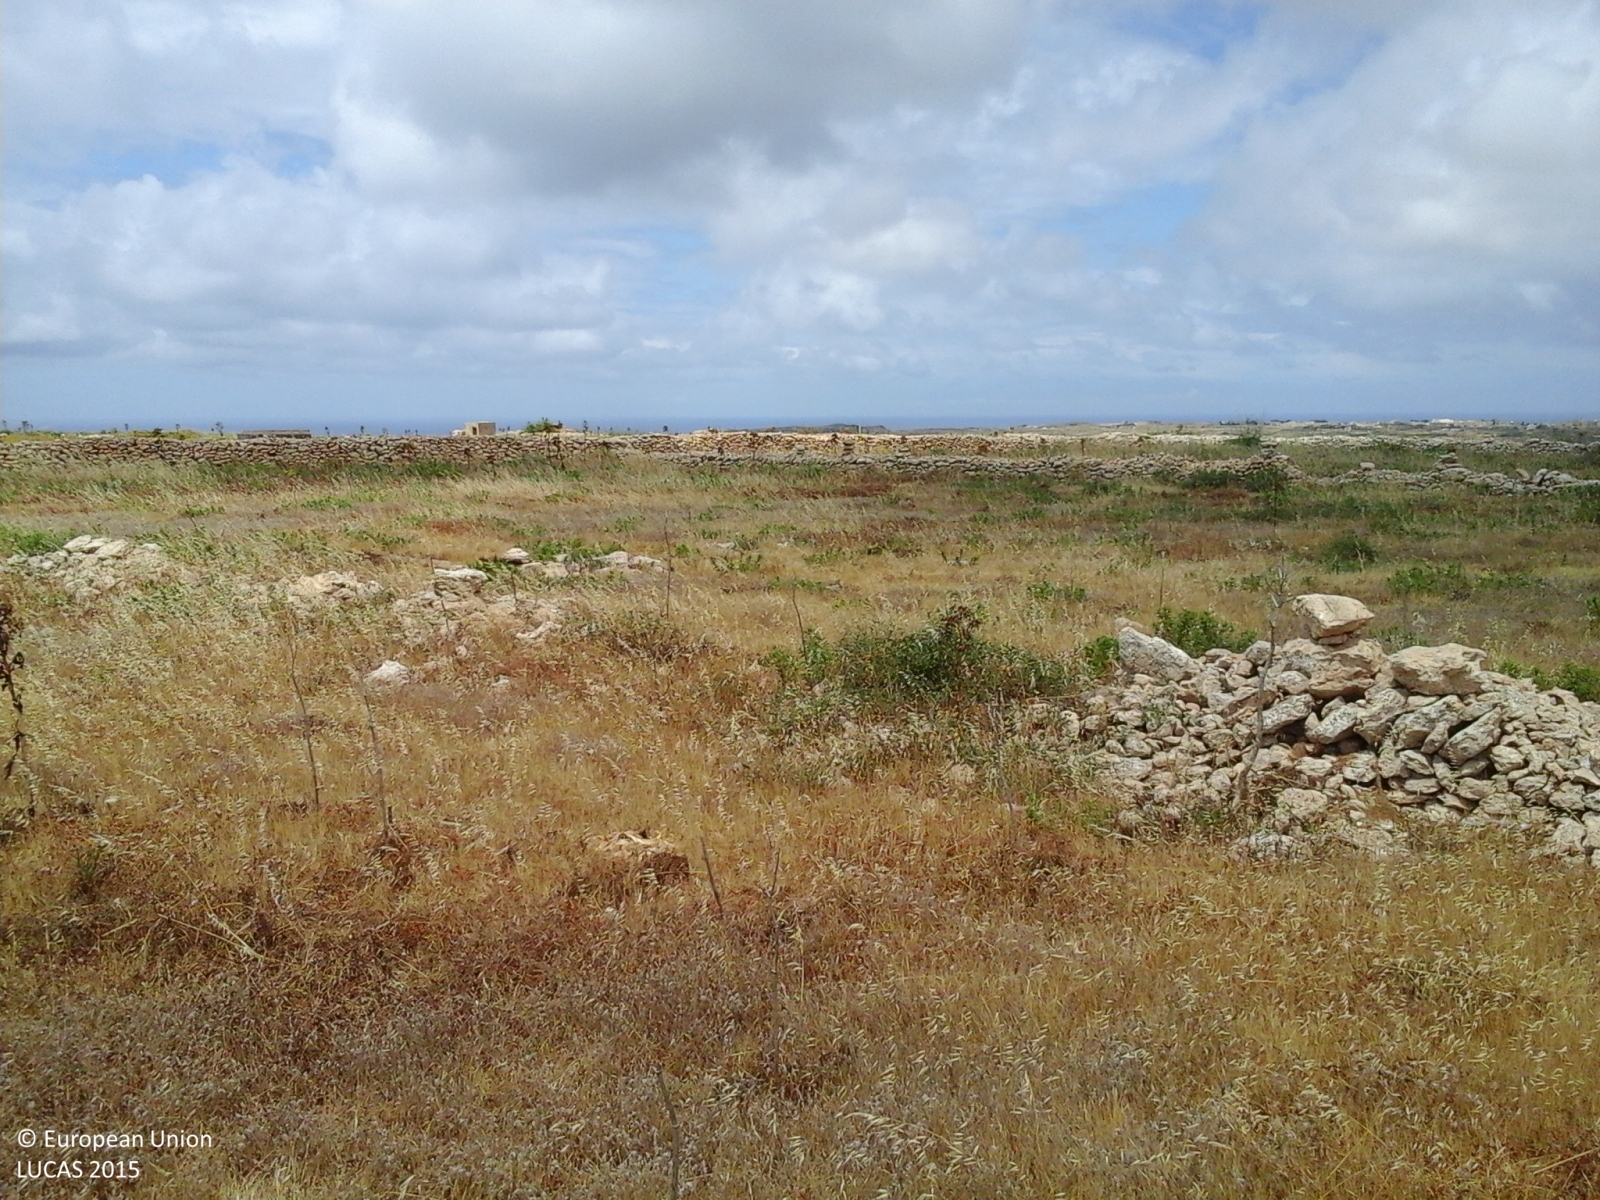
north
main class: Grassland
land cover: Grassland without tree/shrub cover
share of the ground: > 75 %
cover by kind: herbaceous plants 95 %
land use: Abandoned areas
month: May
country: MT
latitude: 36.0360
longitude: 14.1902
